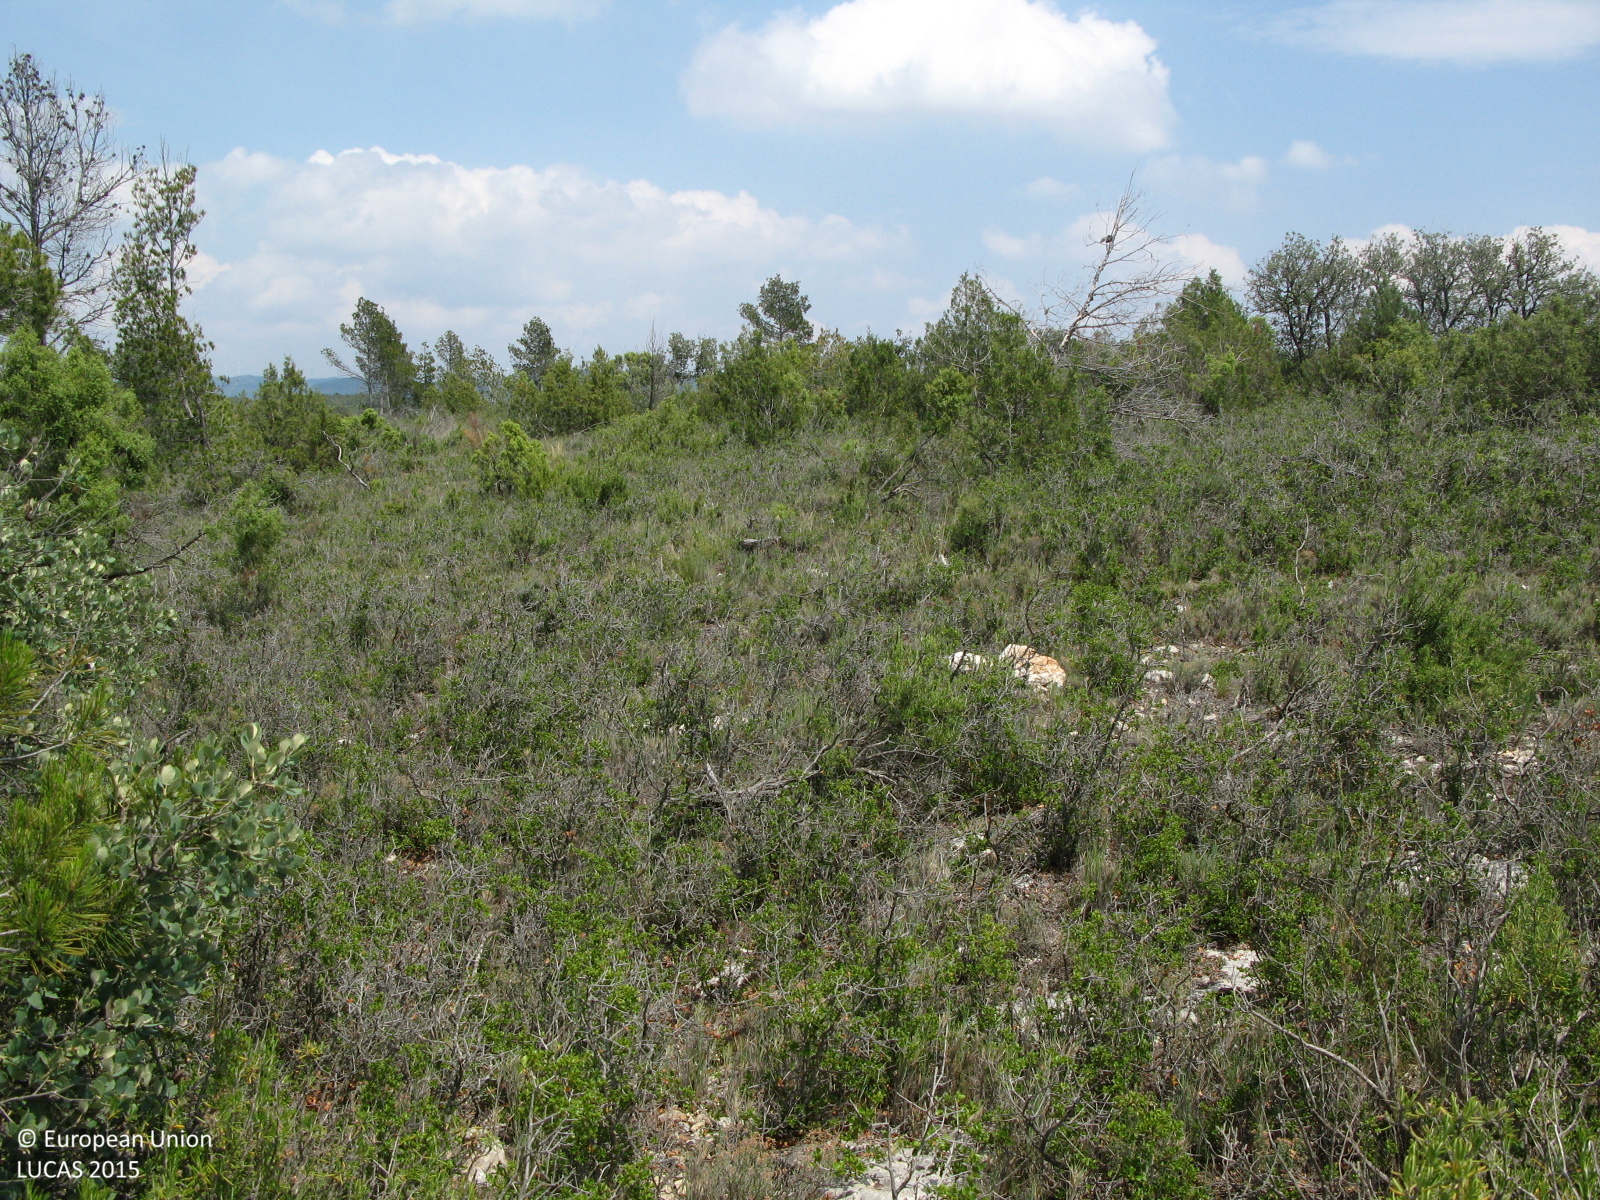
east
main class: Woodland
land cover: Broadleaved woodland
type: broadleaved evergreen forest
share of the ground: 10 - 25 %
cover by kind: broadleaved forest trees 35 %, shrubs 35 %, consolidated bare surface 15 %, herbaceous plants 10 %, coniferous forest trees 5 %
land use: Forestry
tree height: < 5 m
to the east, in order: Broadleaved woodland; Shrubland without tree cover; Broadleaved woodland; Shrubland without tree cover; Tracks; Nuts trees
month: June
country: ES
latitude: 39.7962
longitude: -0.9701
